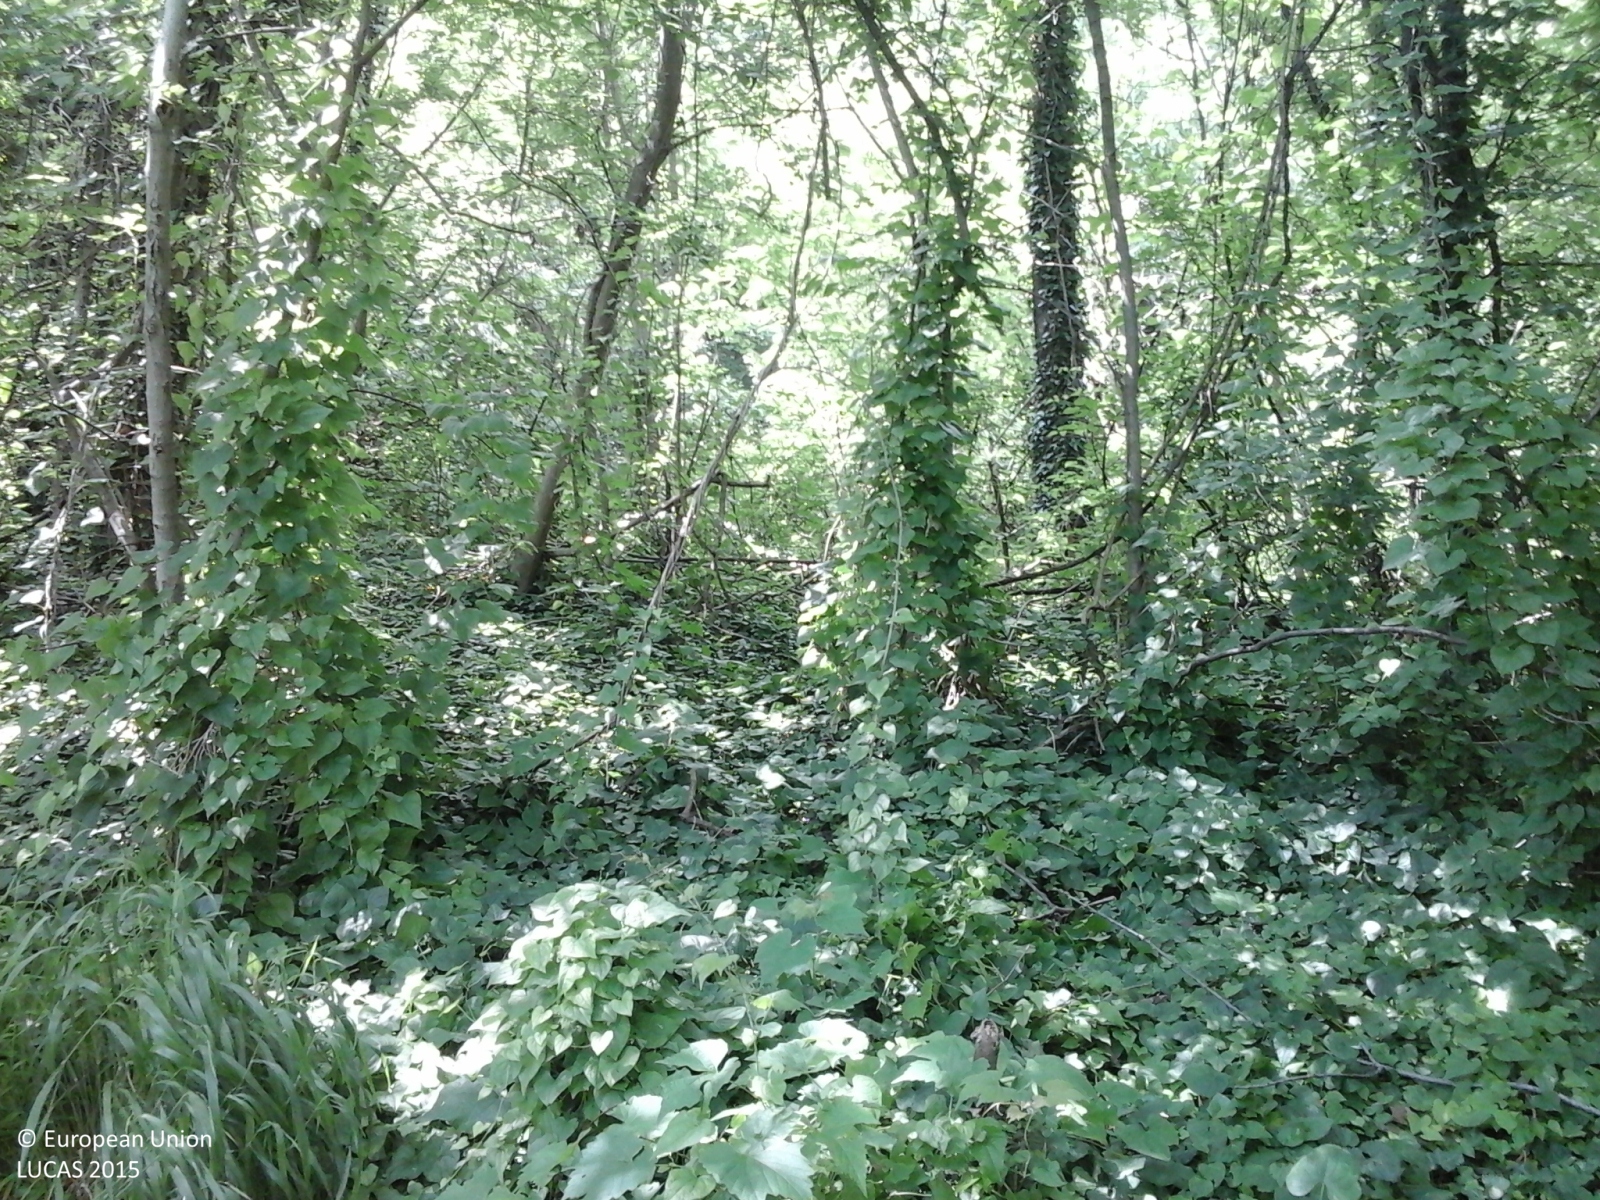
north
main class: Woodland
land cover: Broadleaved woodland
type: mesophytic deciduous forest
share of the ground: > 75 %
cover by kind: broadleaved forest trees 80 %, shrubs 20 %
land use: Forestry
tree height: > 5 m
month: May
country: IT
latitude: 45.1449
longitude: 8.1084
